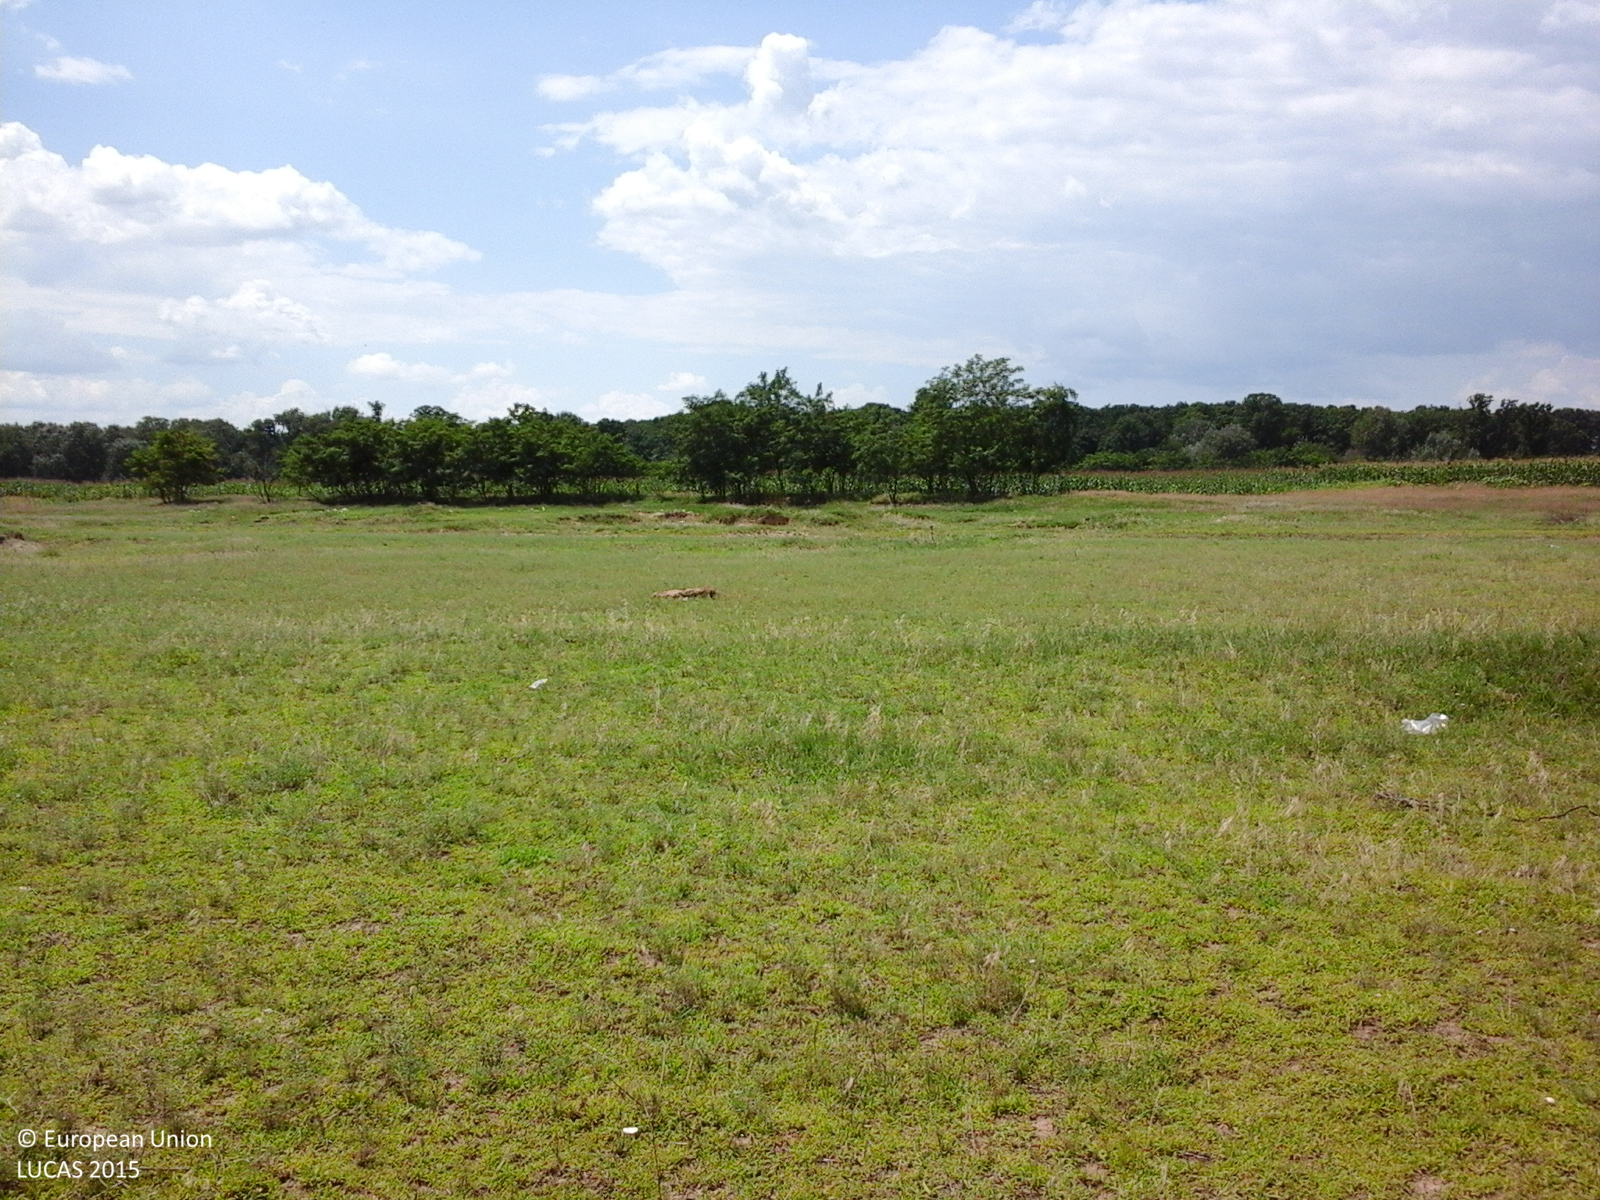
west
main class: Grassland
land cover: Spontaneously vegetated surfaces
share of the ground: > 75 %
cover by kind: herbaceous plants 100 %
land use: Agriculture (excluding fallow land and kitchen gardens)
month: July
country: RO
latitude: 44.2931
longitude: 24.7754
